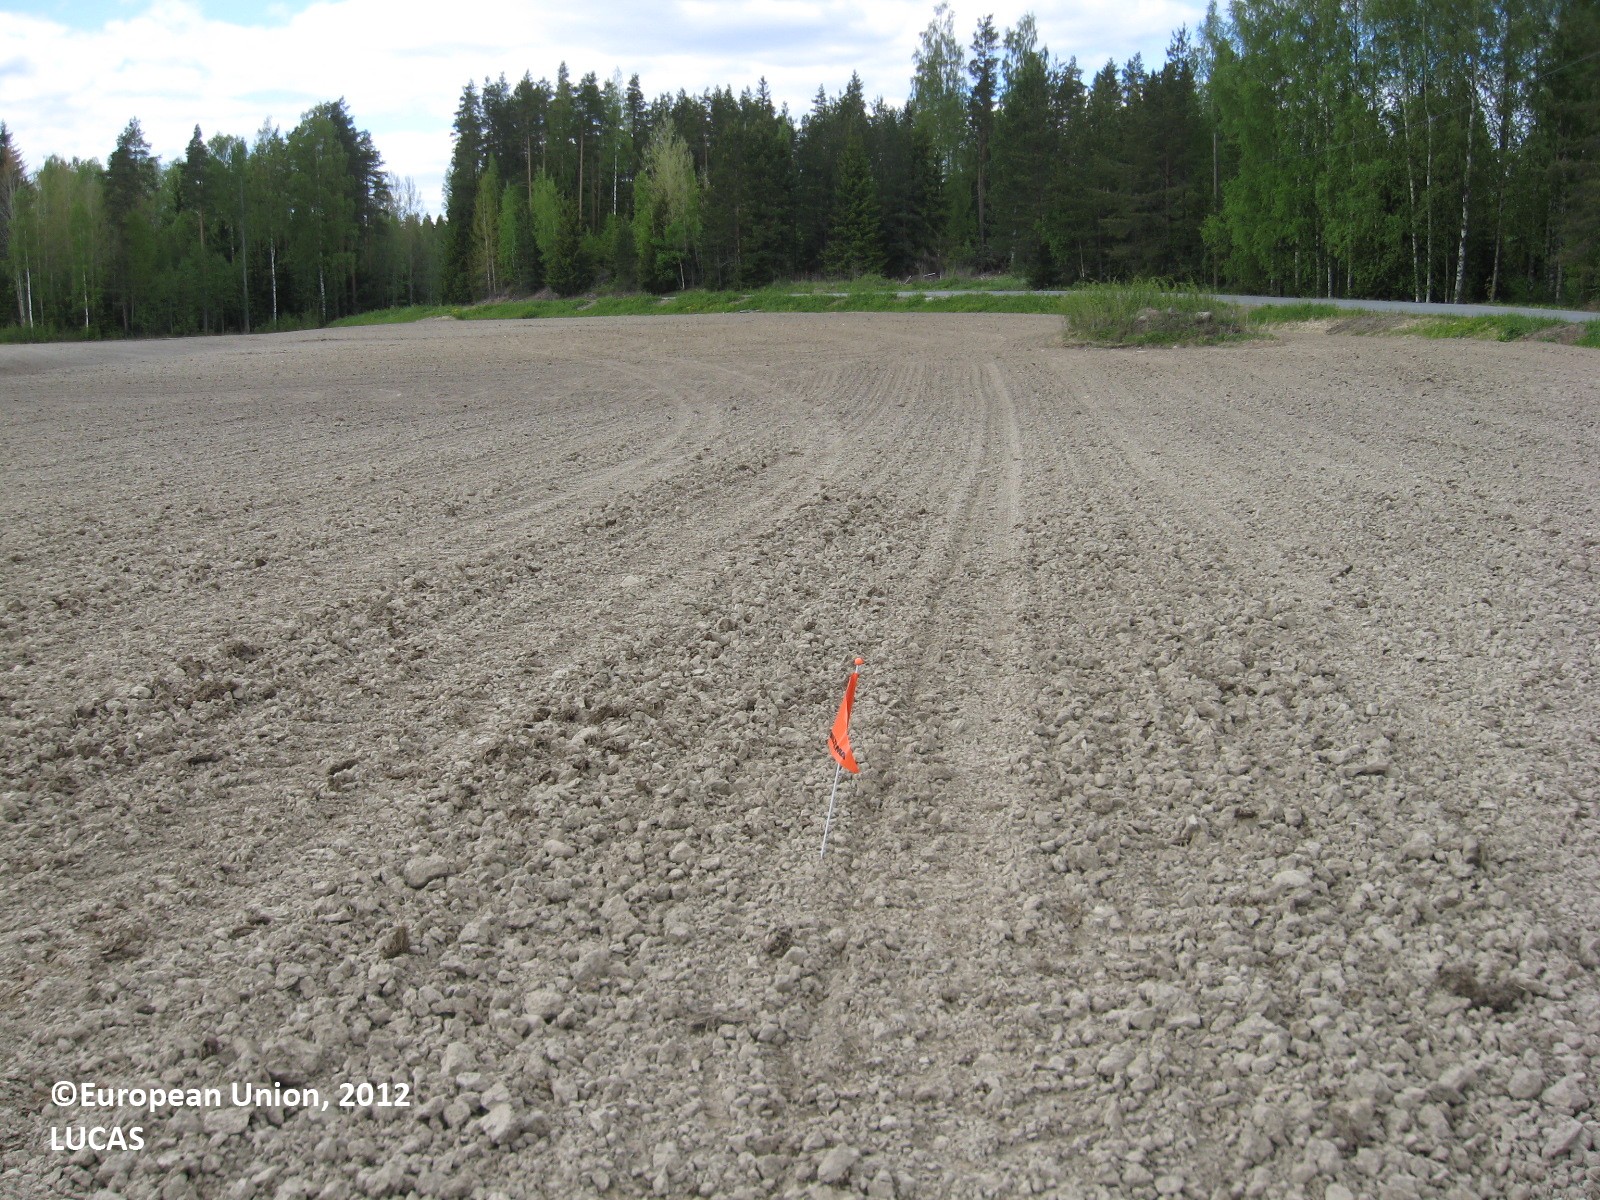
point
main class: Cropland
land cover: Oats
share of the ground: < 10 %
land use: Agriculture (excluding fallow land and kitchen gardens)
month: May
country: FI
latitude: 61.8267
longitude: 22.5739
